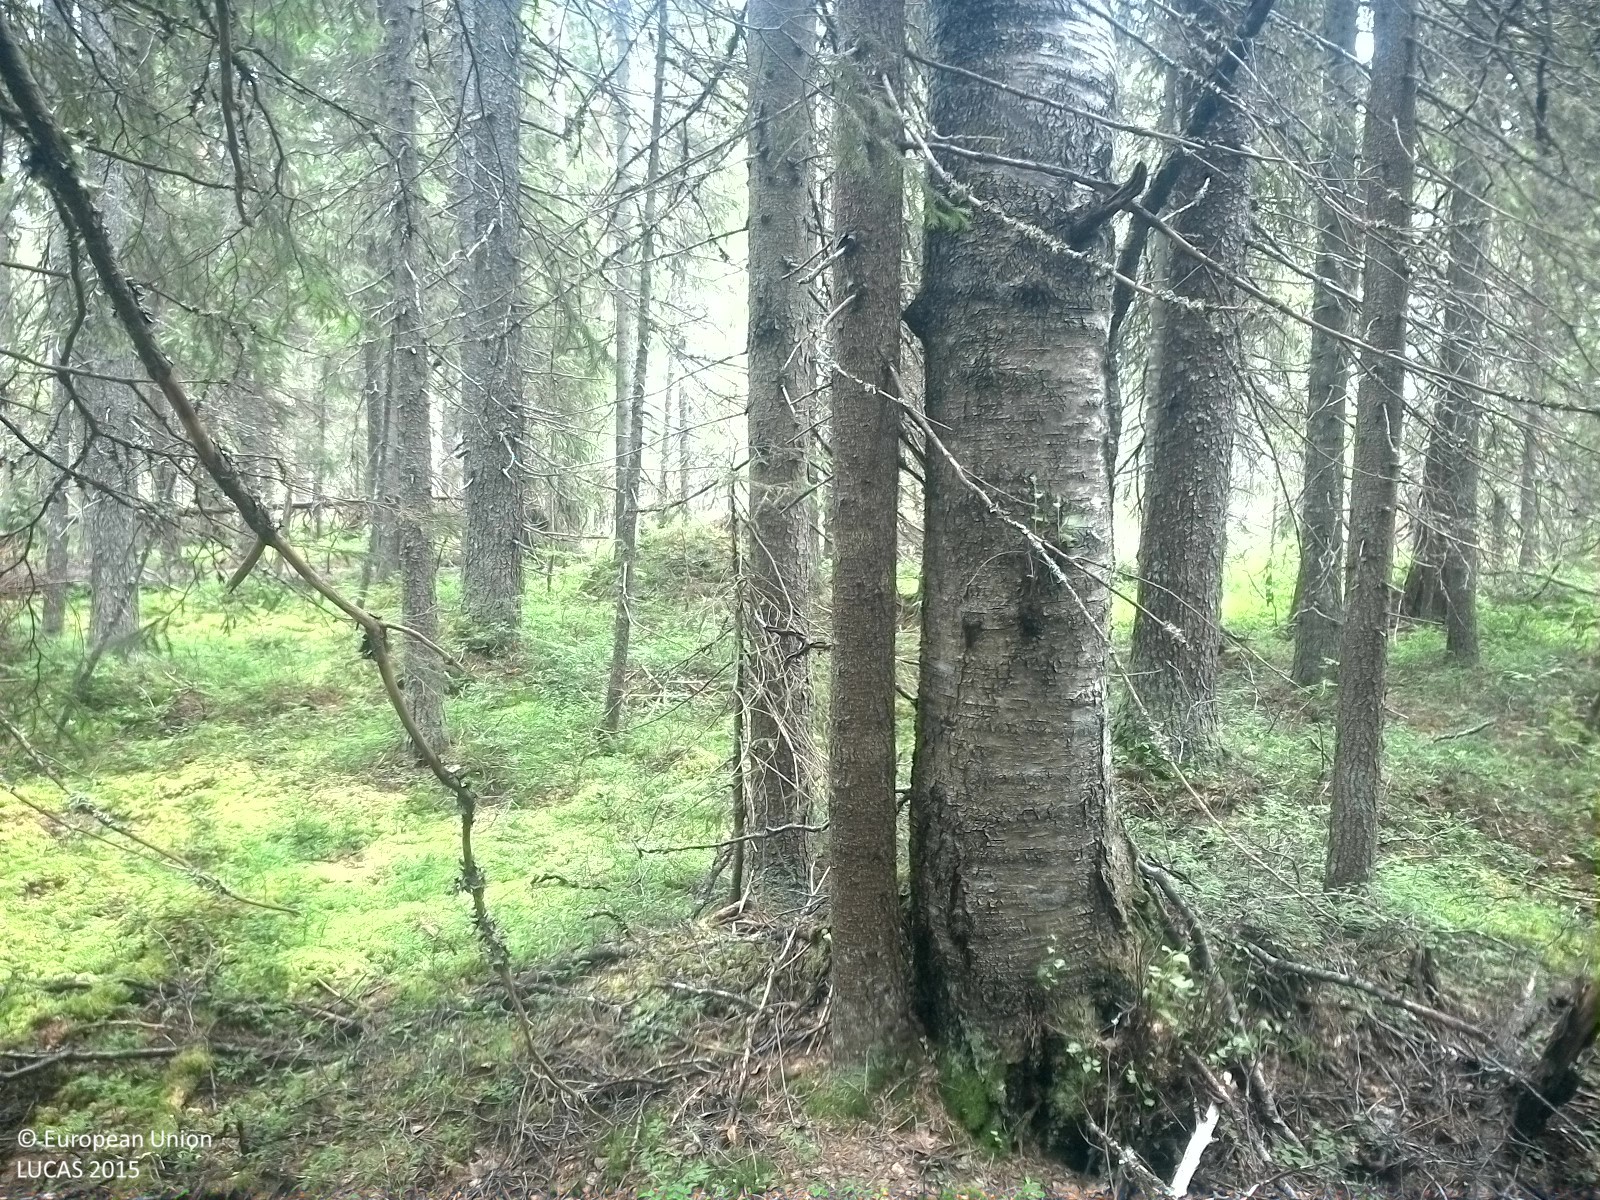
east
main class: Woodland
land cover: Spruce dominated coniferous woodland
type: boreal forest
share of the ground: 50 - 75 %
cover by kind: coniferous forest trees 60 %, lichens and mosses 30 %, herbaceous plants 10 %
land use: Forestry
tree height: > 5 m
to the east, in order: Spruce dominated coniferous woodland; Tracks; Spruce dominated coniferous woodland; Tracks; Spruce dominated coniferous woodland; Shrubland with sparse tree cover; Spruce dominated coniferous woodland
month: July
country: SE
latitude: 62.5581
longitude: 17.7410
